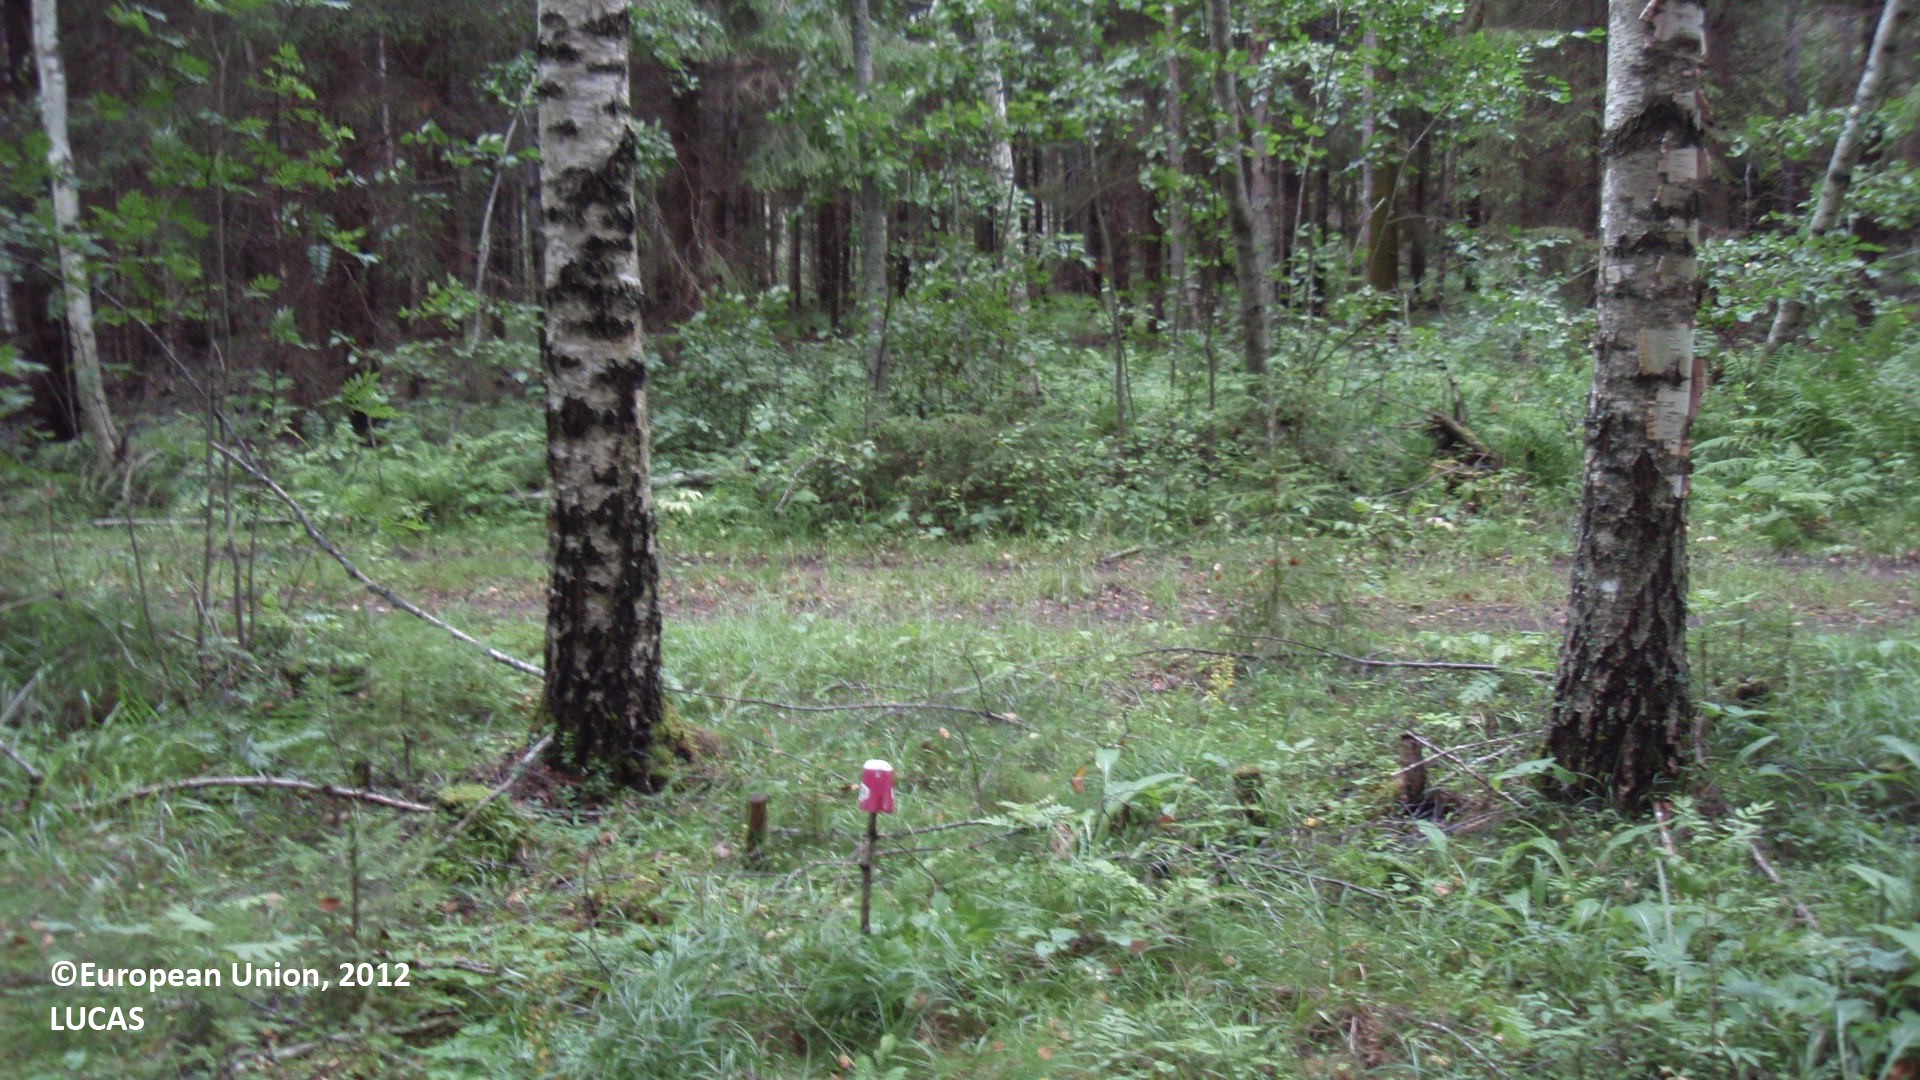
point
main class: Woodland
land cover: Spruce dominated mixed woodland
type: boreal forest
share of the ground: 50 - 75 %
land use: Forestry
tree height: > 5 m
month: August
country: FI
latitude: 61.0376
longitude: 27.3380
